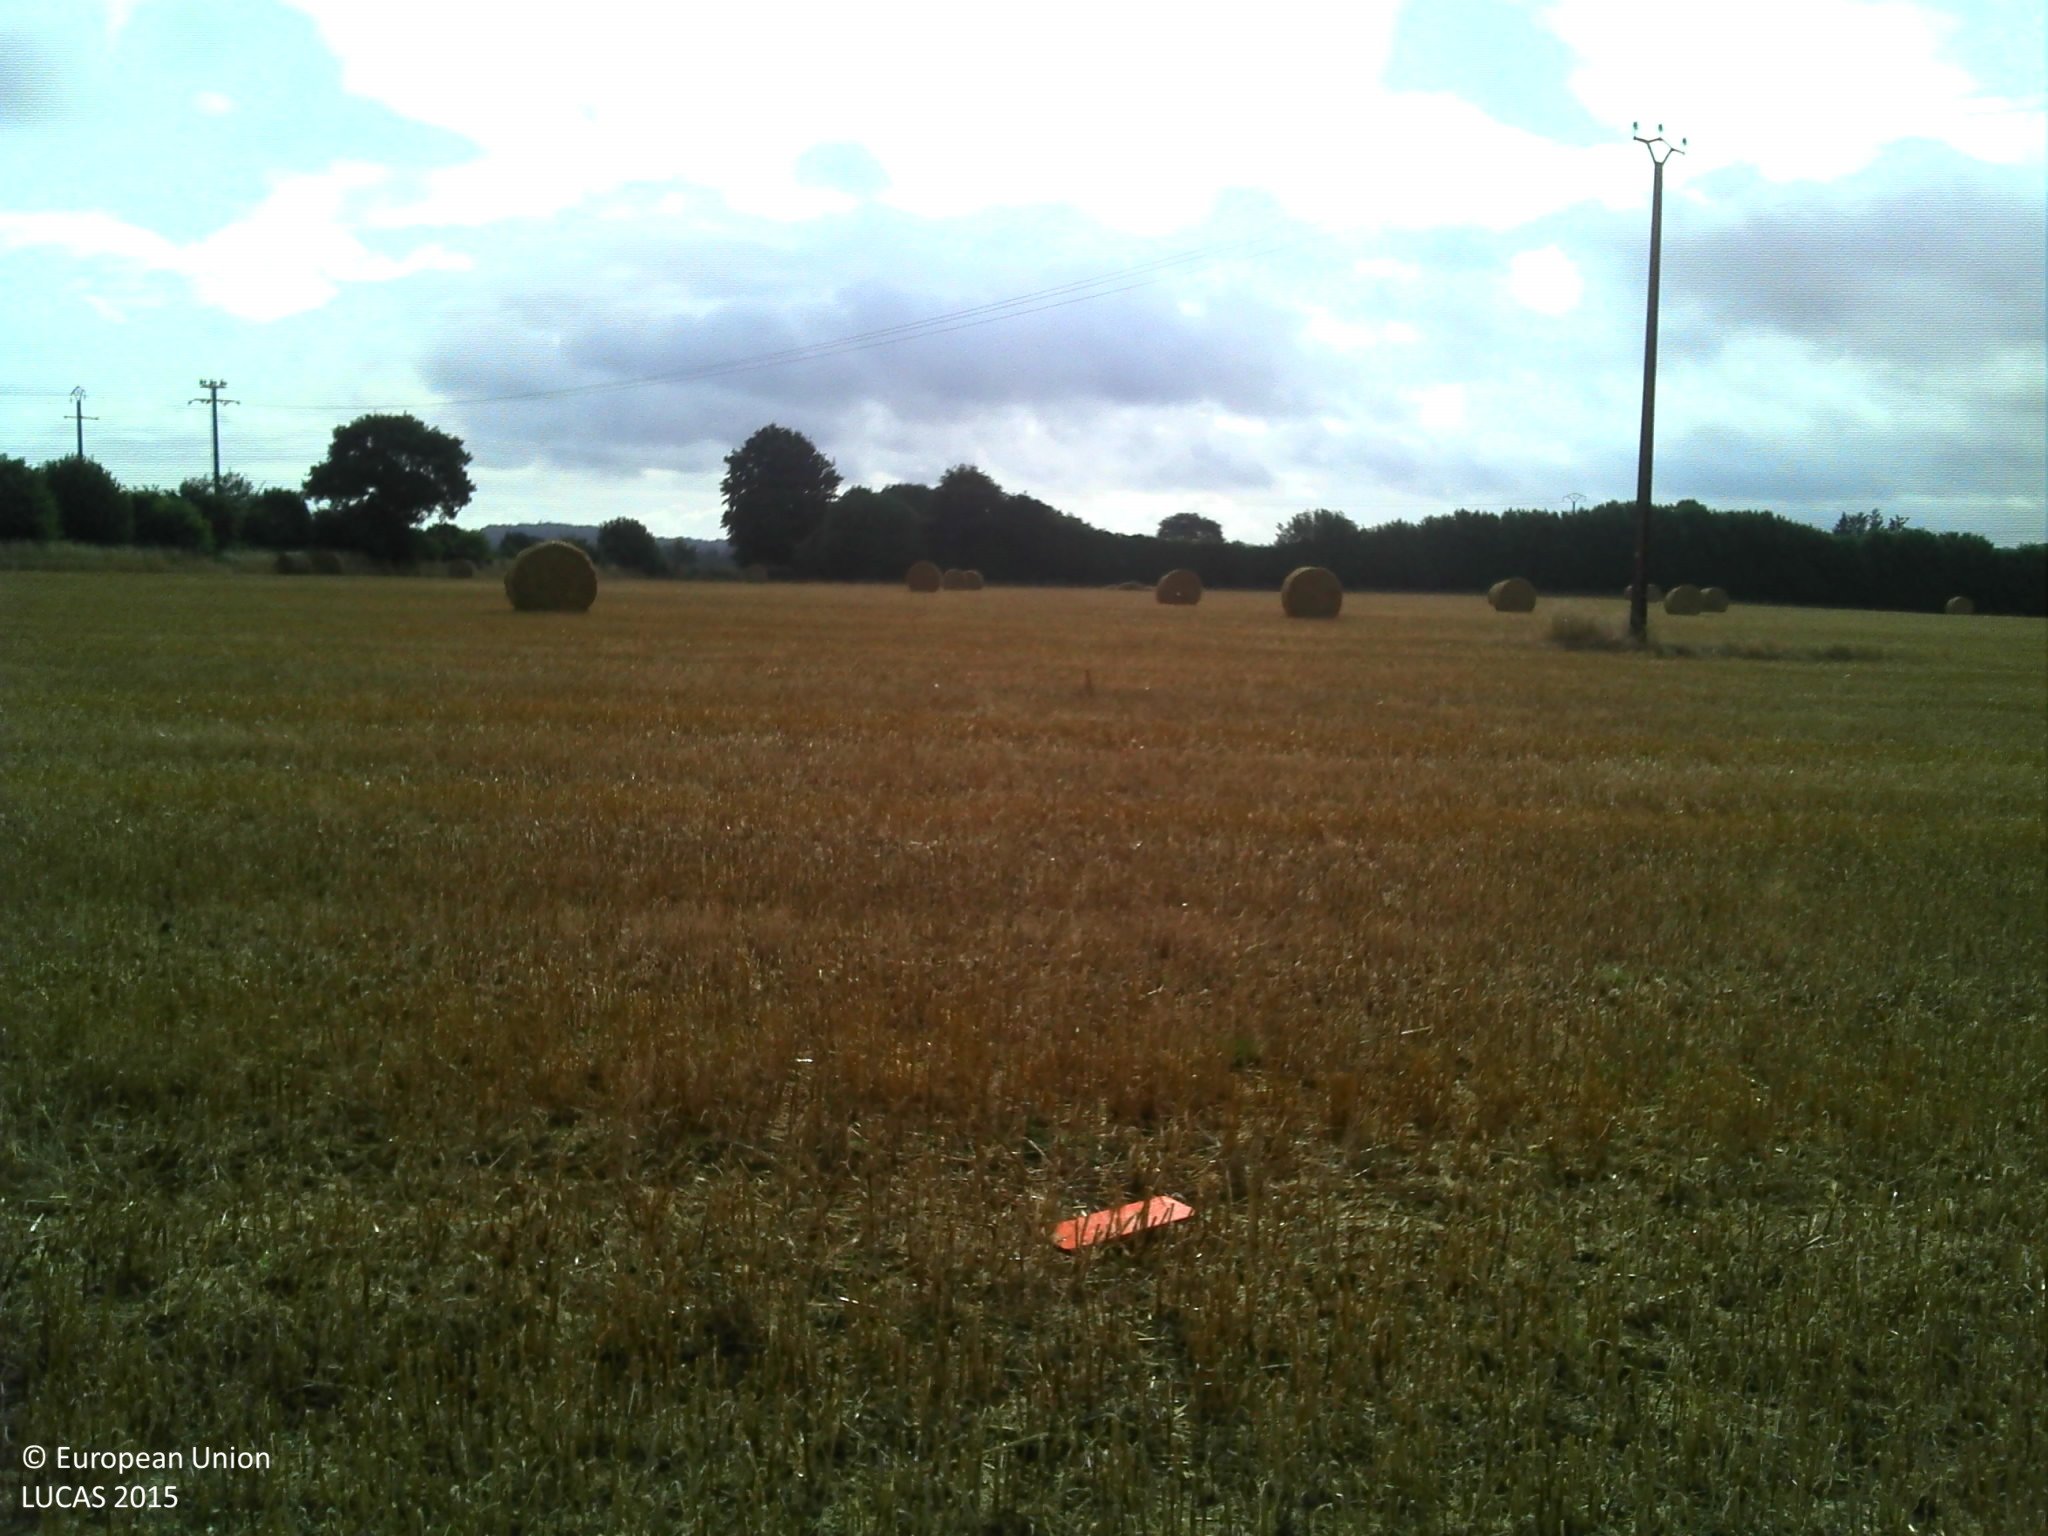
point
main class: Cropland
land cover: Common wheat
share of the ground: > 75 %
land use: Agriculture (excluding fallow land and kitchen gardens)
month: August
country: FR
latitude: 48.2824
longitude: -3.0474
